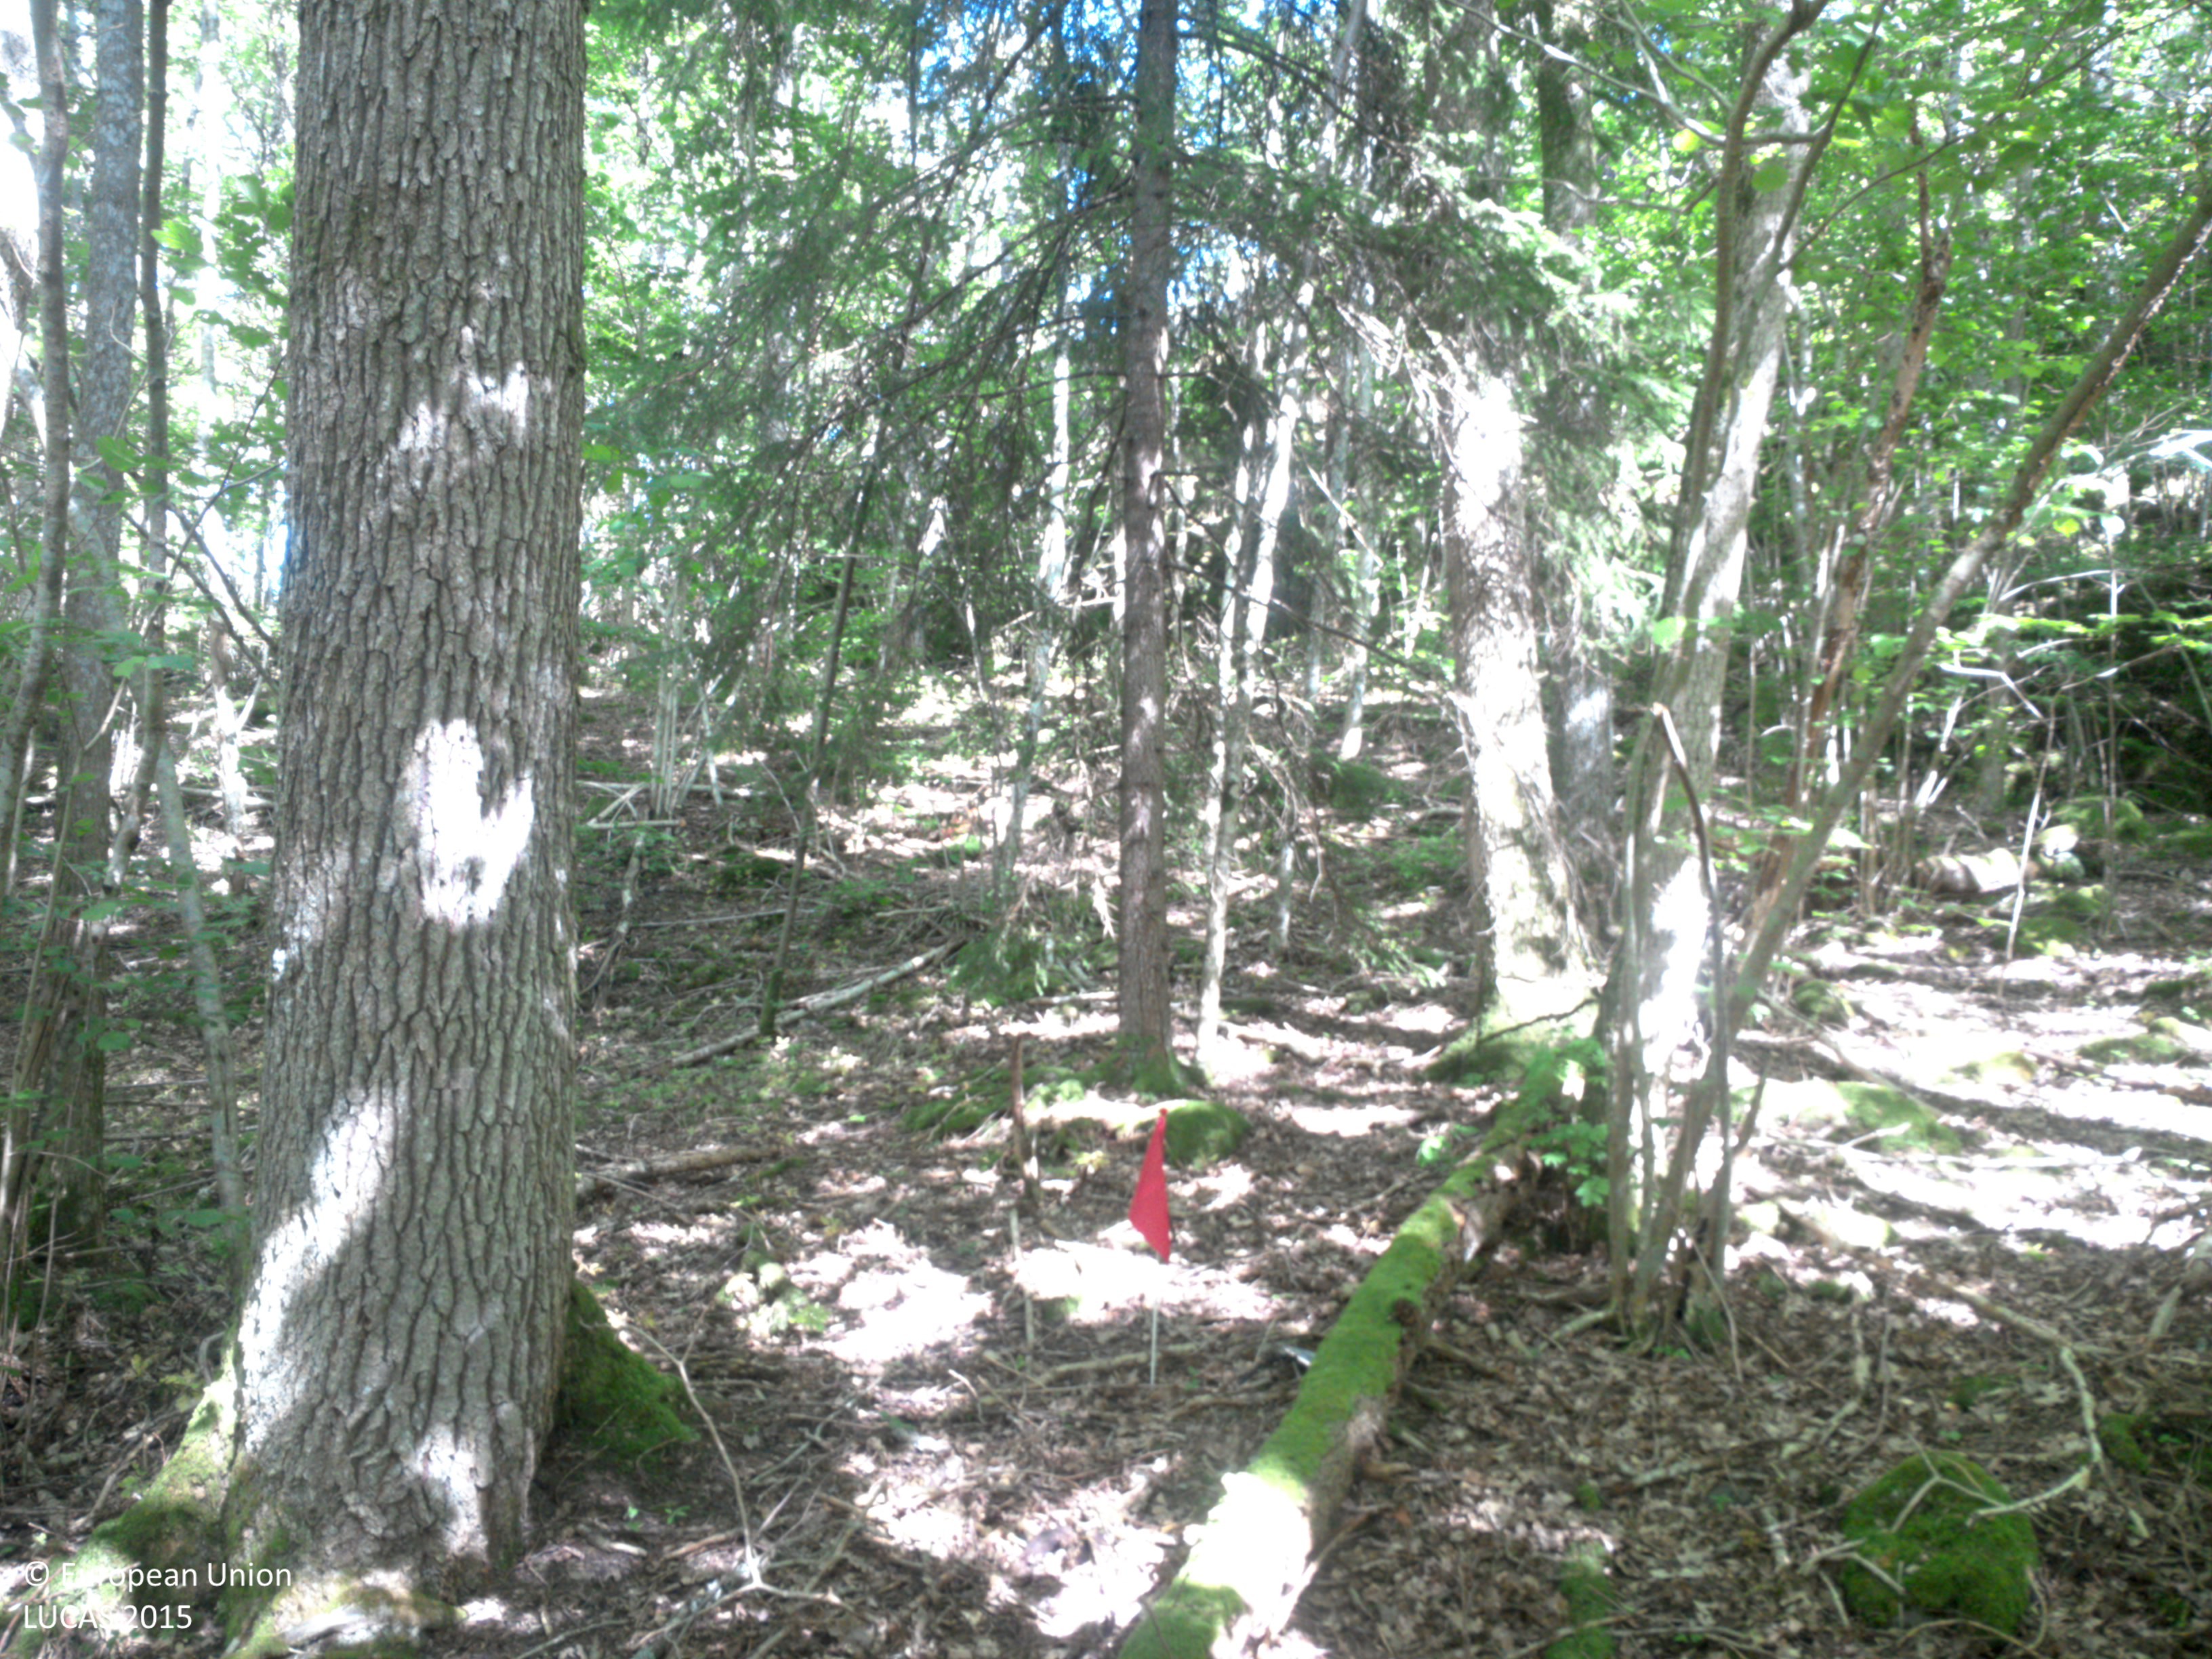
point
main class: Woodland
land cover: Broadleaved woodland
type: hemiboreal forest and nemoral coniferous forest and mixed broadleaved-coniferous forest
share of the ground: > 75 %
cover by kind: broadleaved forest trees 85 %, lichens and mosses 15 %
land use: Amenities, museums, leisure
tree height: > 5 m
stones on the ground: < 10 %
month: June
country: SE
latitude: 58.4607
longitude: 11.6933
